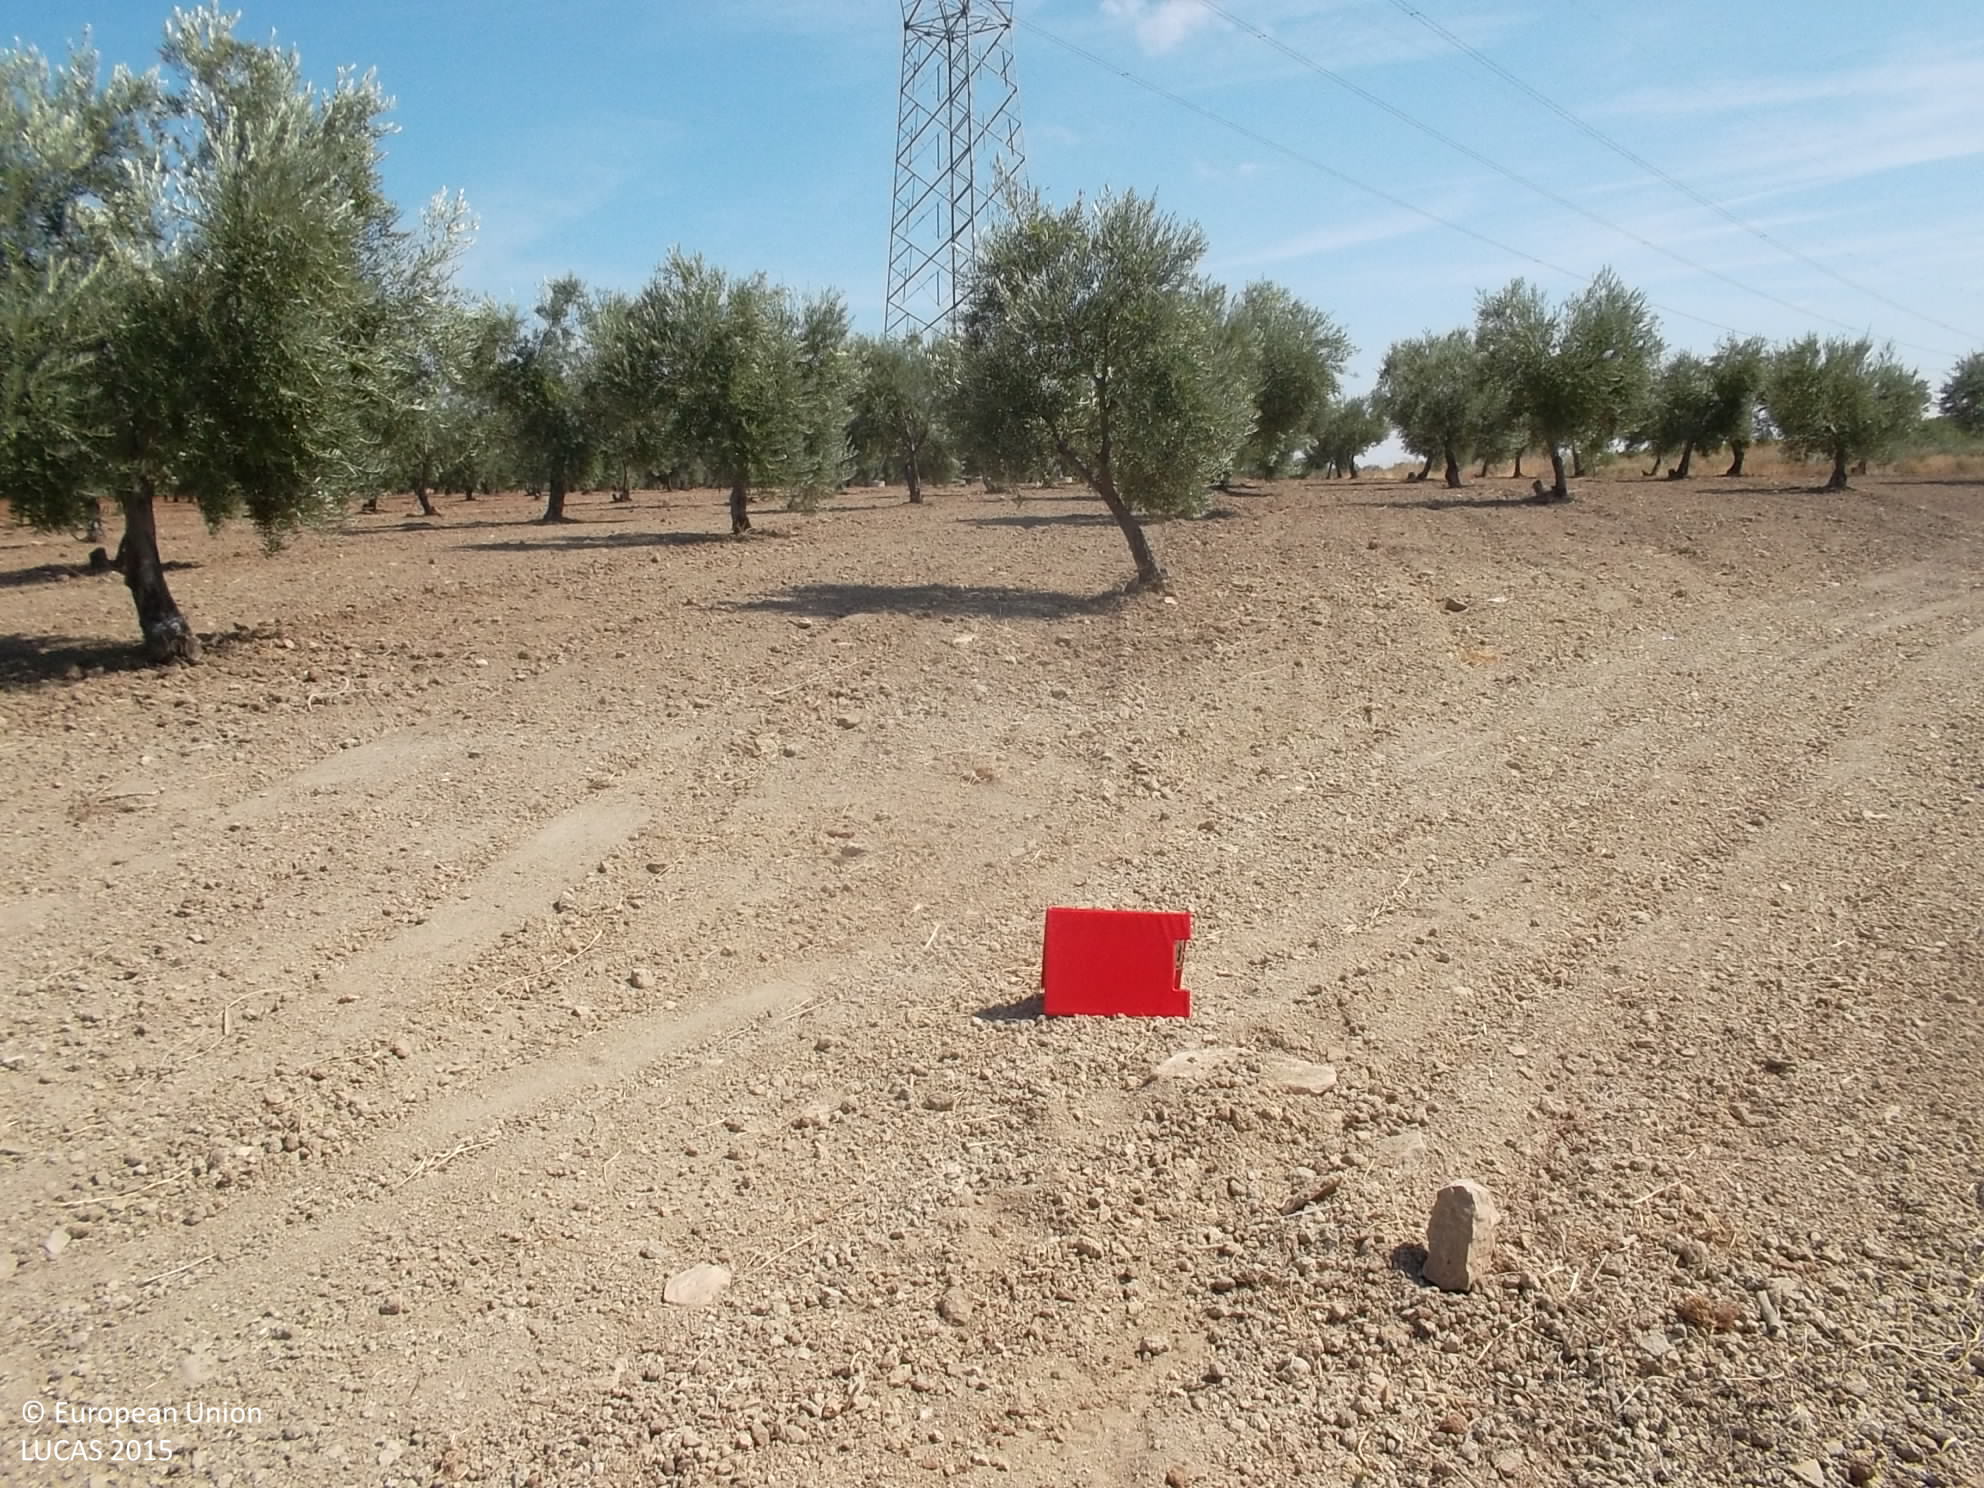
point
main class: Cropland
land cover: Olive groves
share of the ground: 10 - 25 %
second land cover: Other bare soil
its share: > 75 %
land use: Agriculture (excluding fallow land and kitchen gardens)
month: September
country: ES
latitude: 38.3227
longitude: -6.3002
